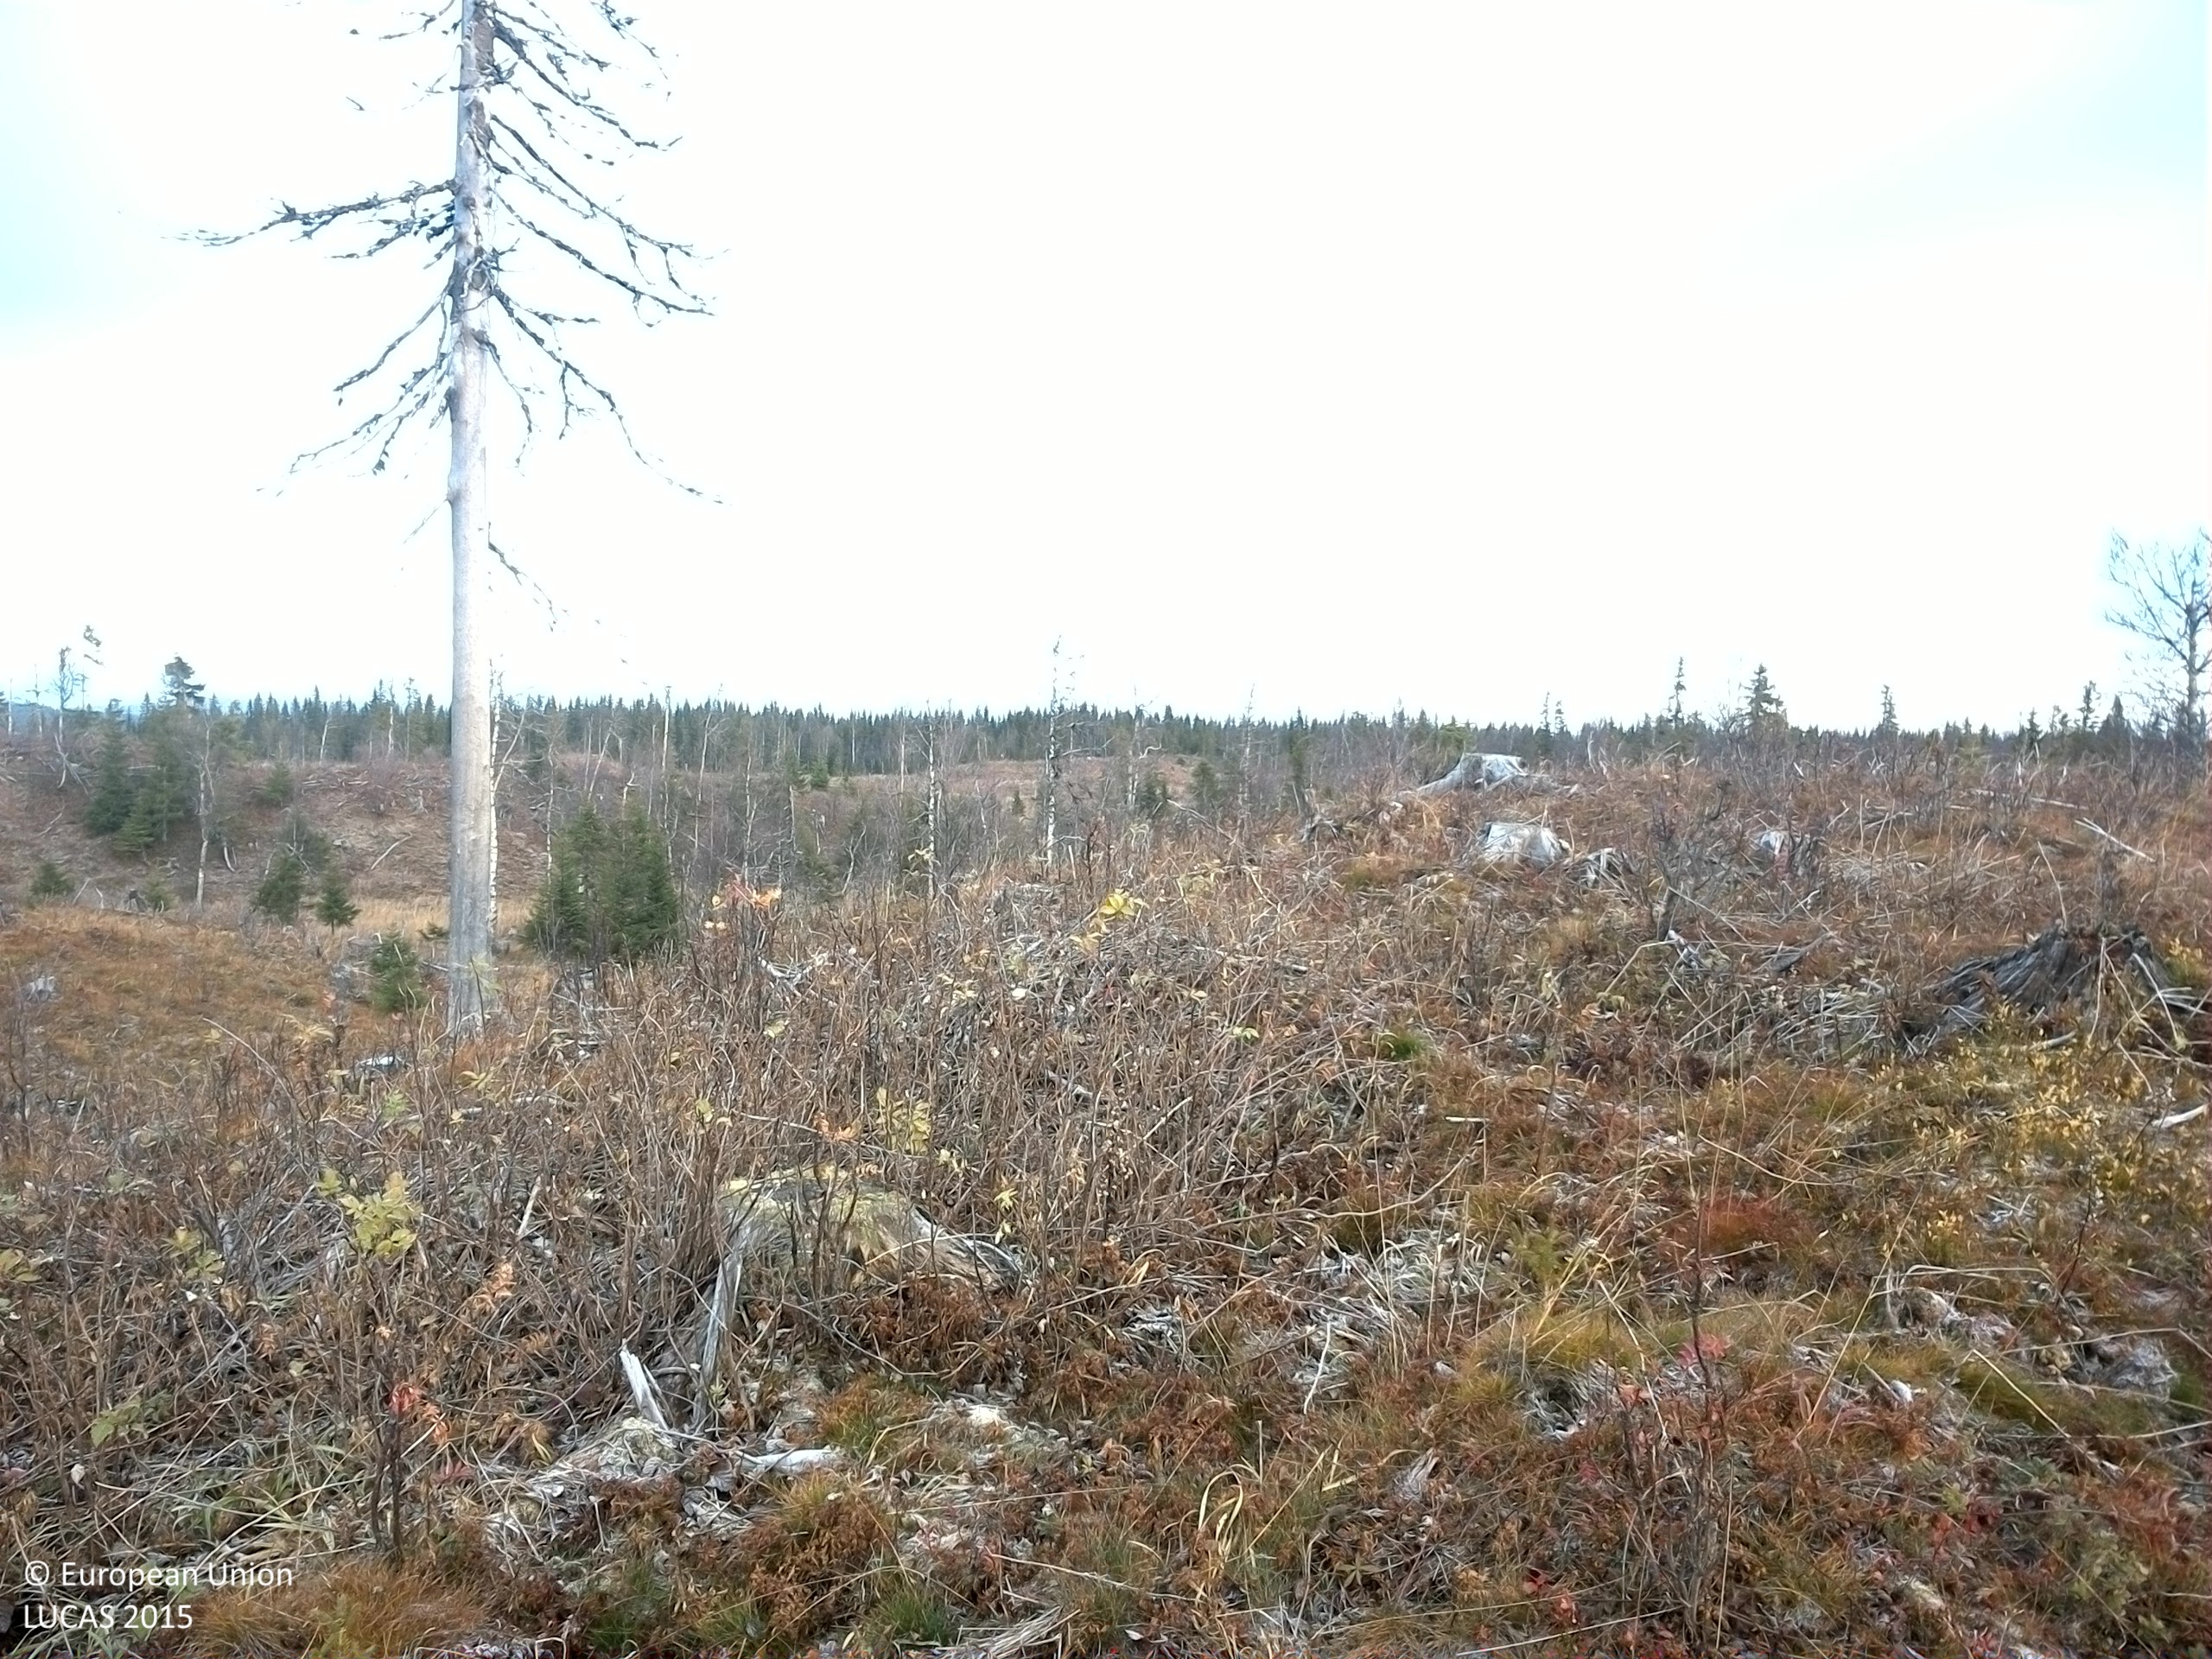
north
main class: Woodland
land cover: Spruce dominated mixed woodland
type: boreal forest
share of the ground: 10 - 25 %
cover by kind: herbaceous plants 55 %, lichens and mosses 20 %, shrubs 15 %, coniferous forest trees 5 %, broadleaved forest trees 5 %
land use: Forestry
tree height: < 5 m
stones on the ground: 25 - 50 %
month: October
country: SE
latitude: 64.1122
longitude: 15.2486
